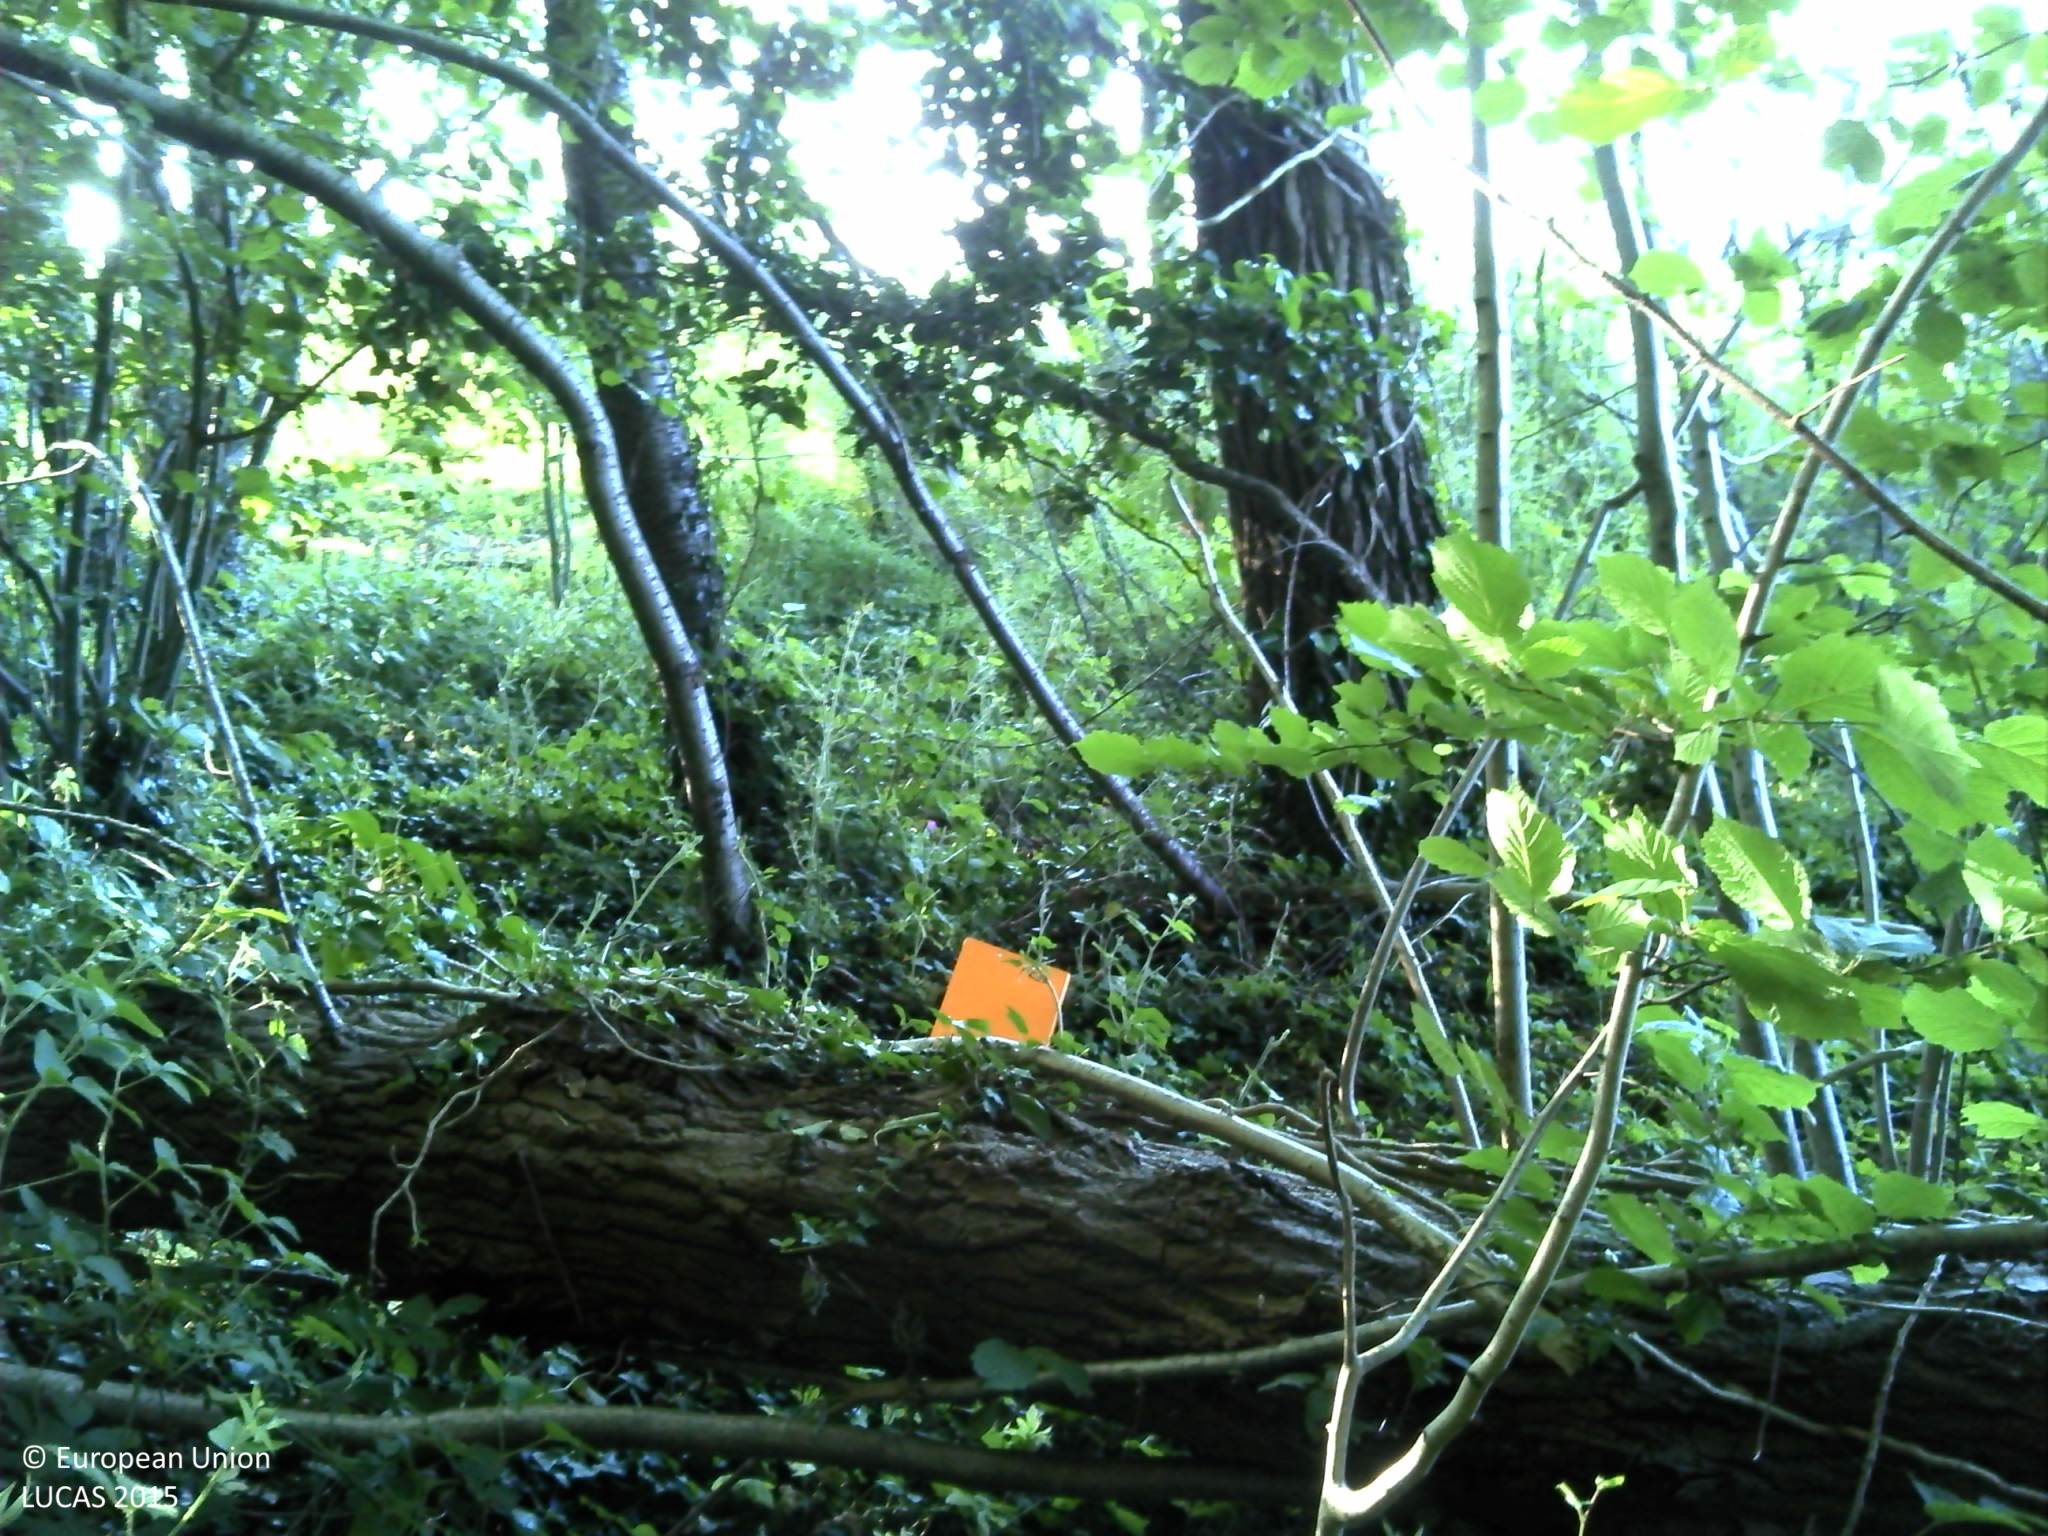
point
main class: Woodland
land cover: Broadleaved woodland
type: mesophytic deciduous forest
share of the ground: > 75 %
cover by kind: broadleaved forest trees 100 %
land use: Forestry
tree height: > 5 m
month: June
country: FR
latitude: 49.7103
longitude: 1.1169
